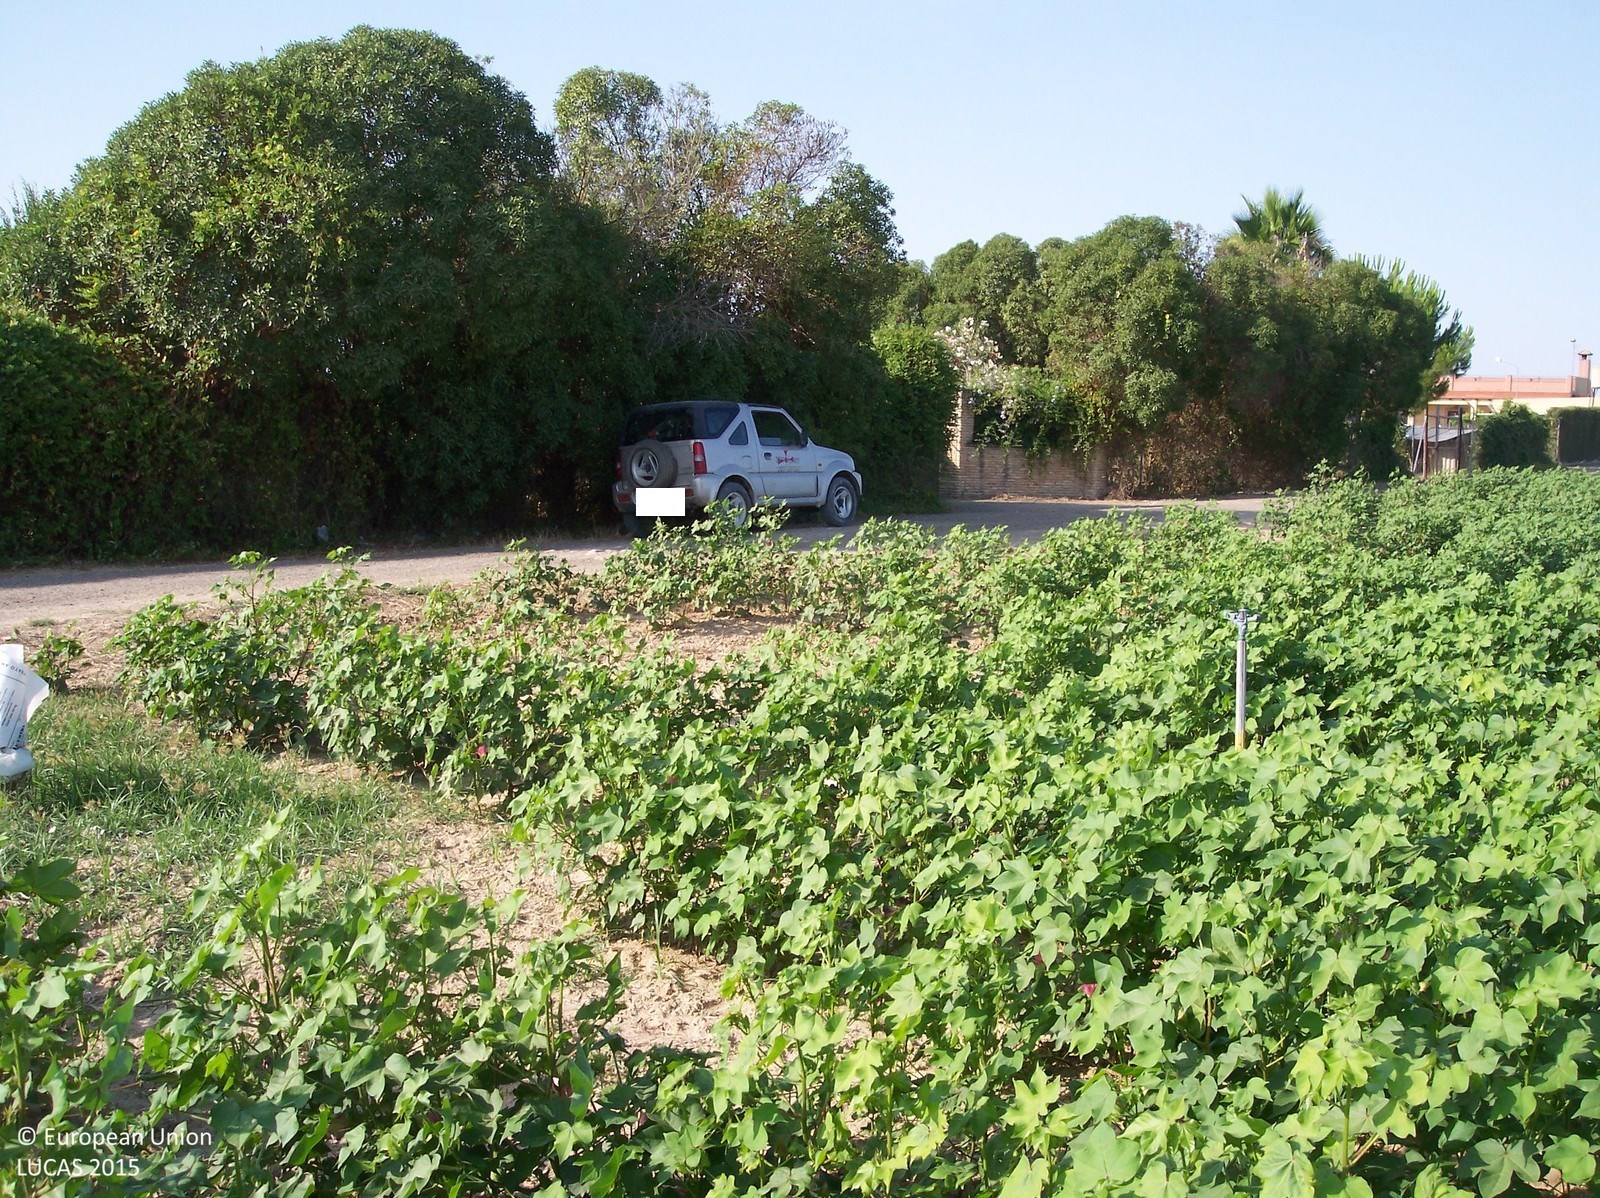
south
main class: Cropland
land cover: Cotton
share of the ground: > 75 %
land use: Agriculture (excluding fallow land and kitchen gardens)
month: July
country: ES
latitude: 37.0603
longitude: -5.8151
